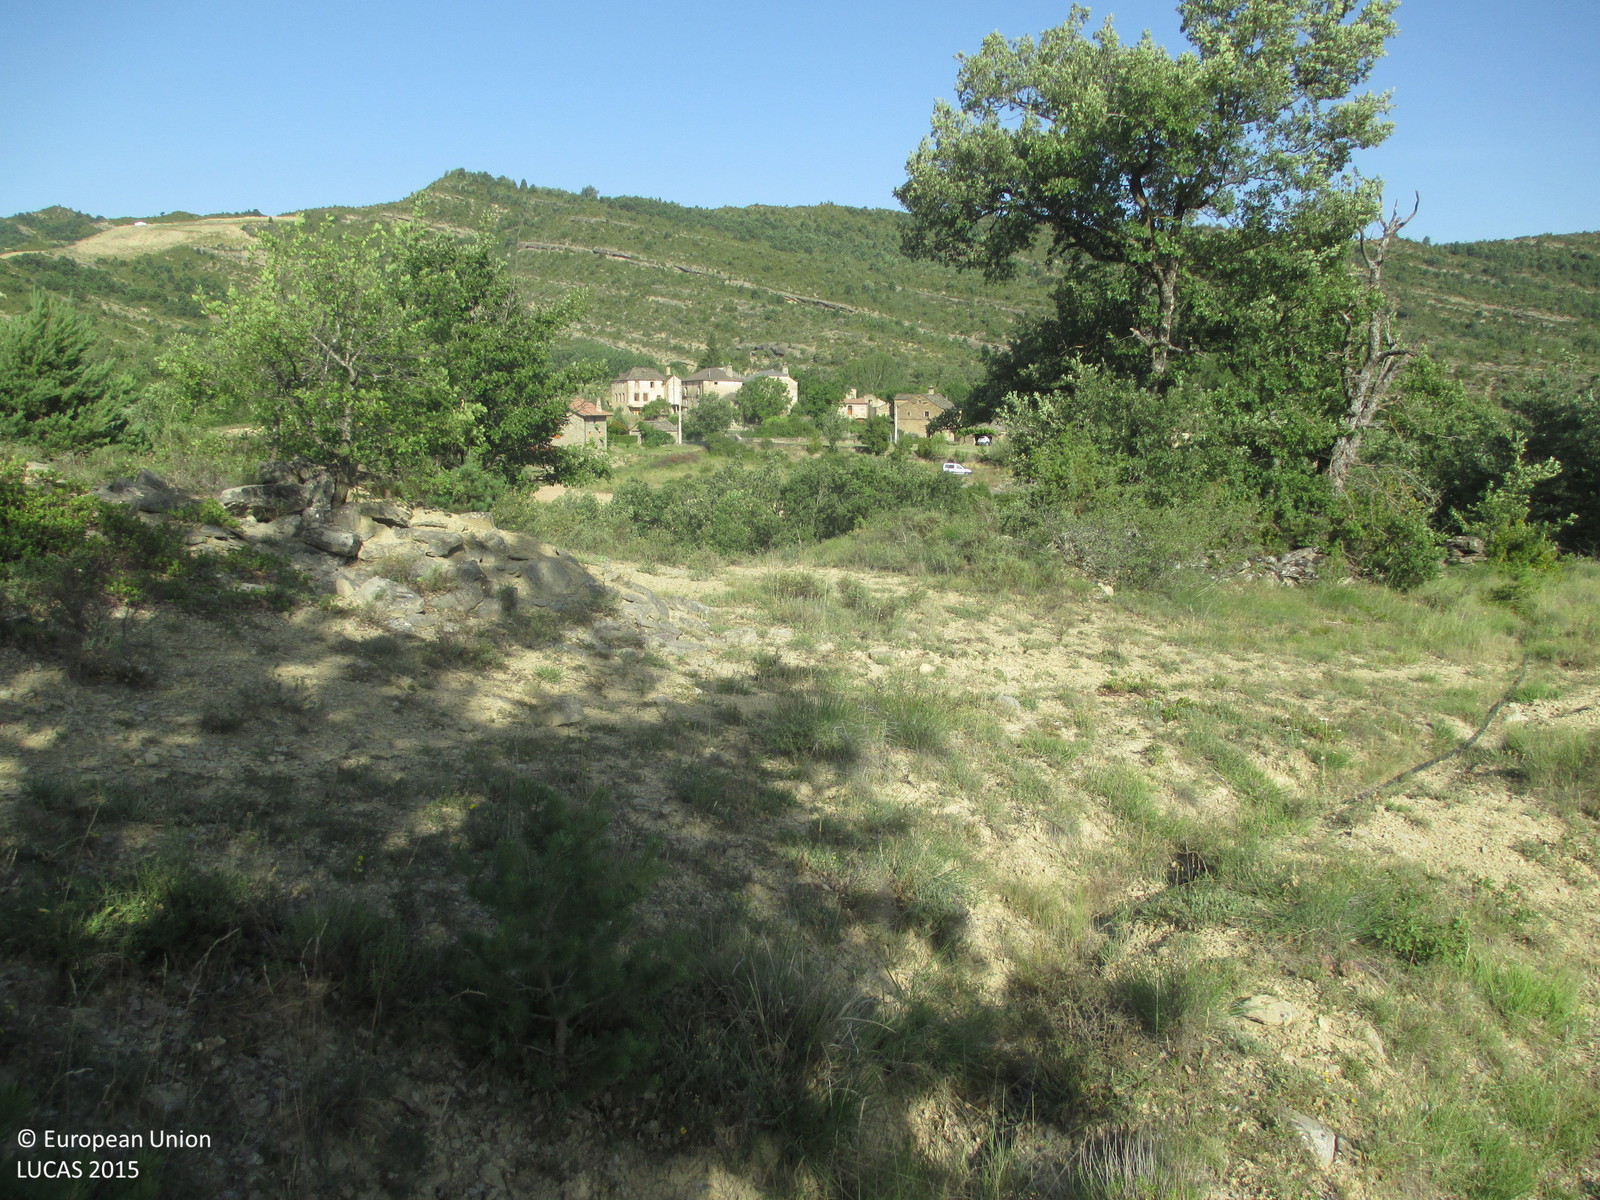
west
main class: Grassland
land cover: Grassland with sparse tree/shrub cover
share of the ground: > 75 %
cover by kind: herbaceous plants 90 %, broadleaved forest trees 5 %, shrubs 5 %
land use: Semi-natural and natural areas not in use
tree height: > 5 m
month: July
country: ES
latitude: 42.3762
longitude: -0.3592
